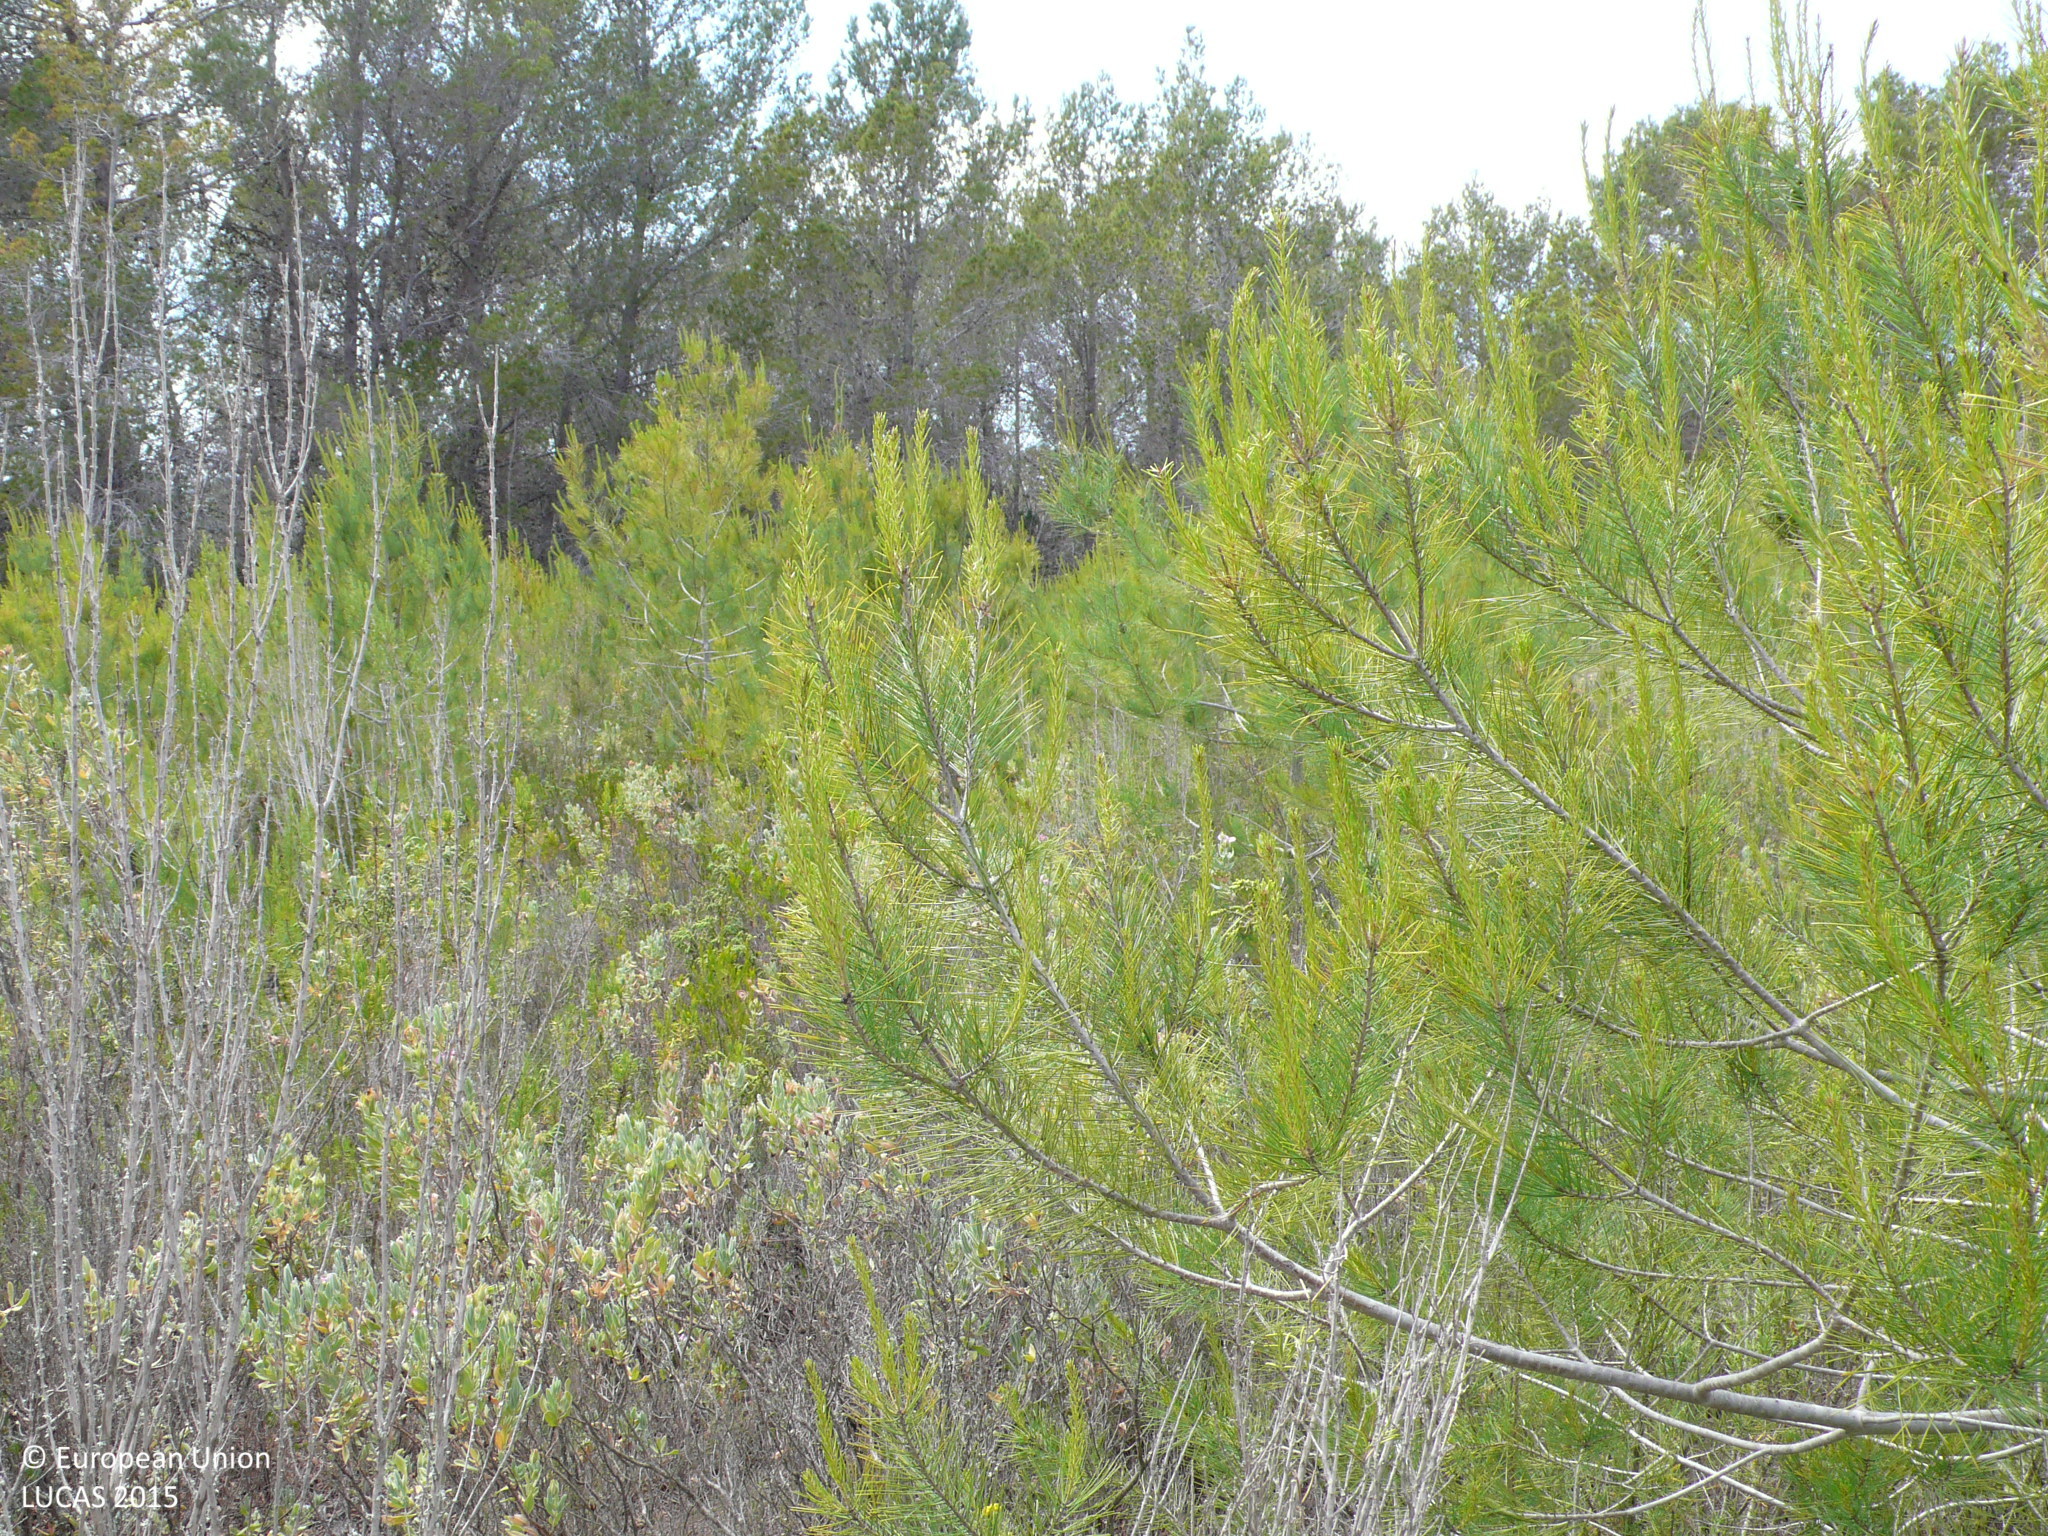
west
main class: Woodland
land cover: Pine dominated coniferous woodland
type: coniferous forest of the mediterranean region
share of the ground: 25 - 50 %
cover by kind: shrubs 60 %, coniferous forest trees 40 %
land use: Forestry
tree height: < 5 m
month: May
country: ES
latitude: 39.0763
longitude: 1.4691
